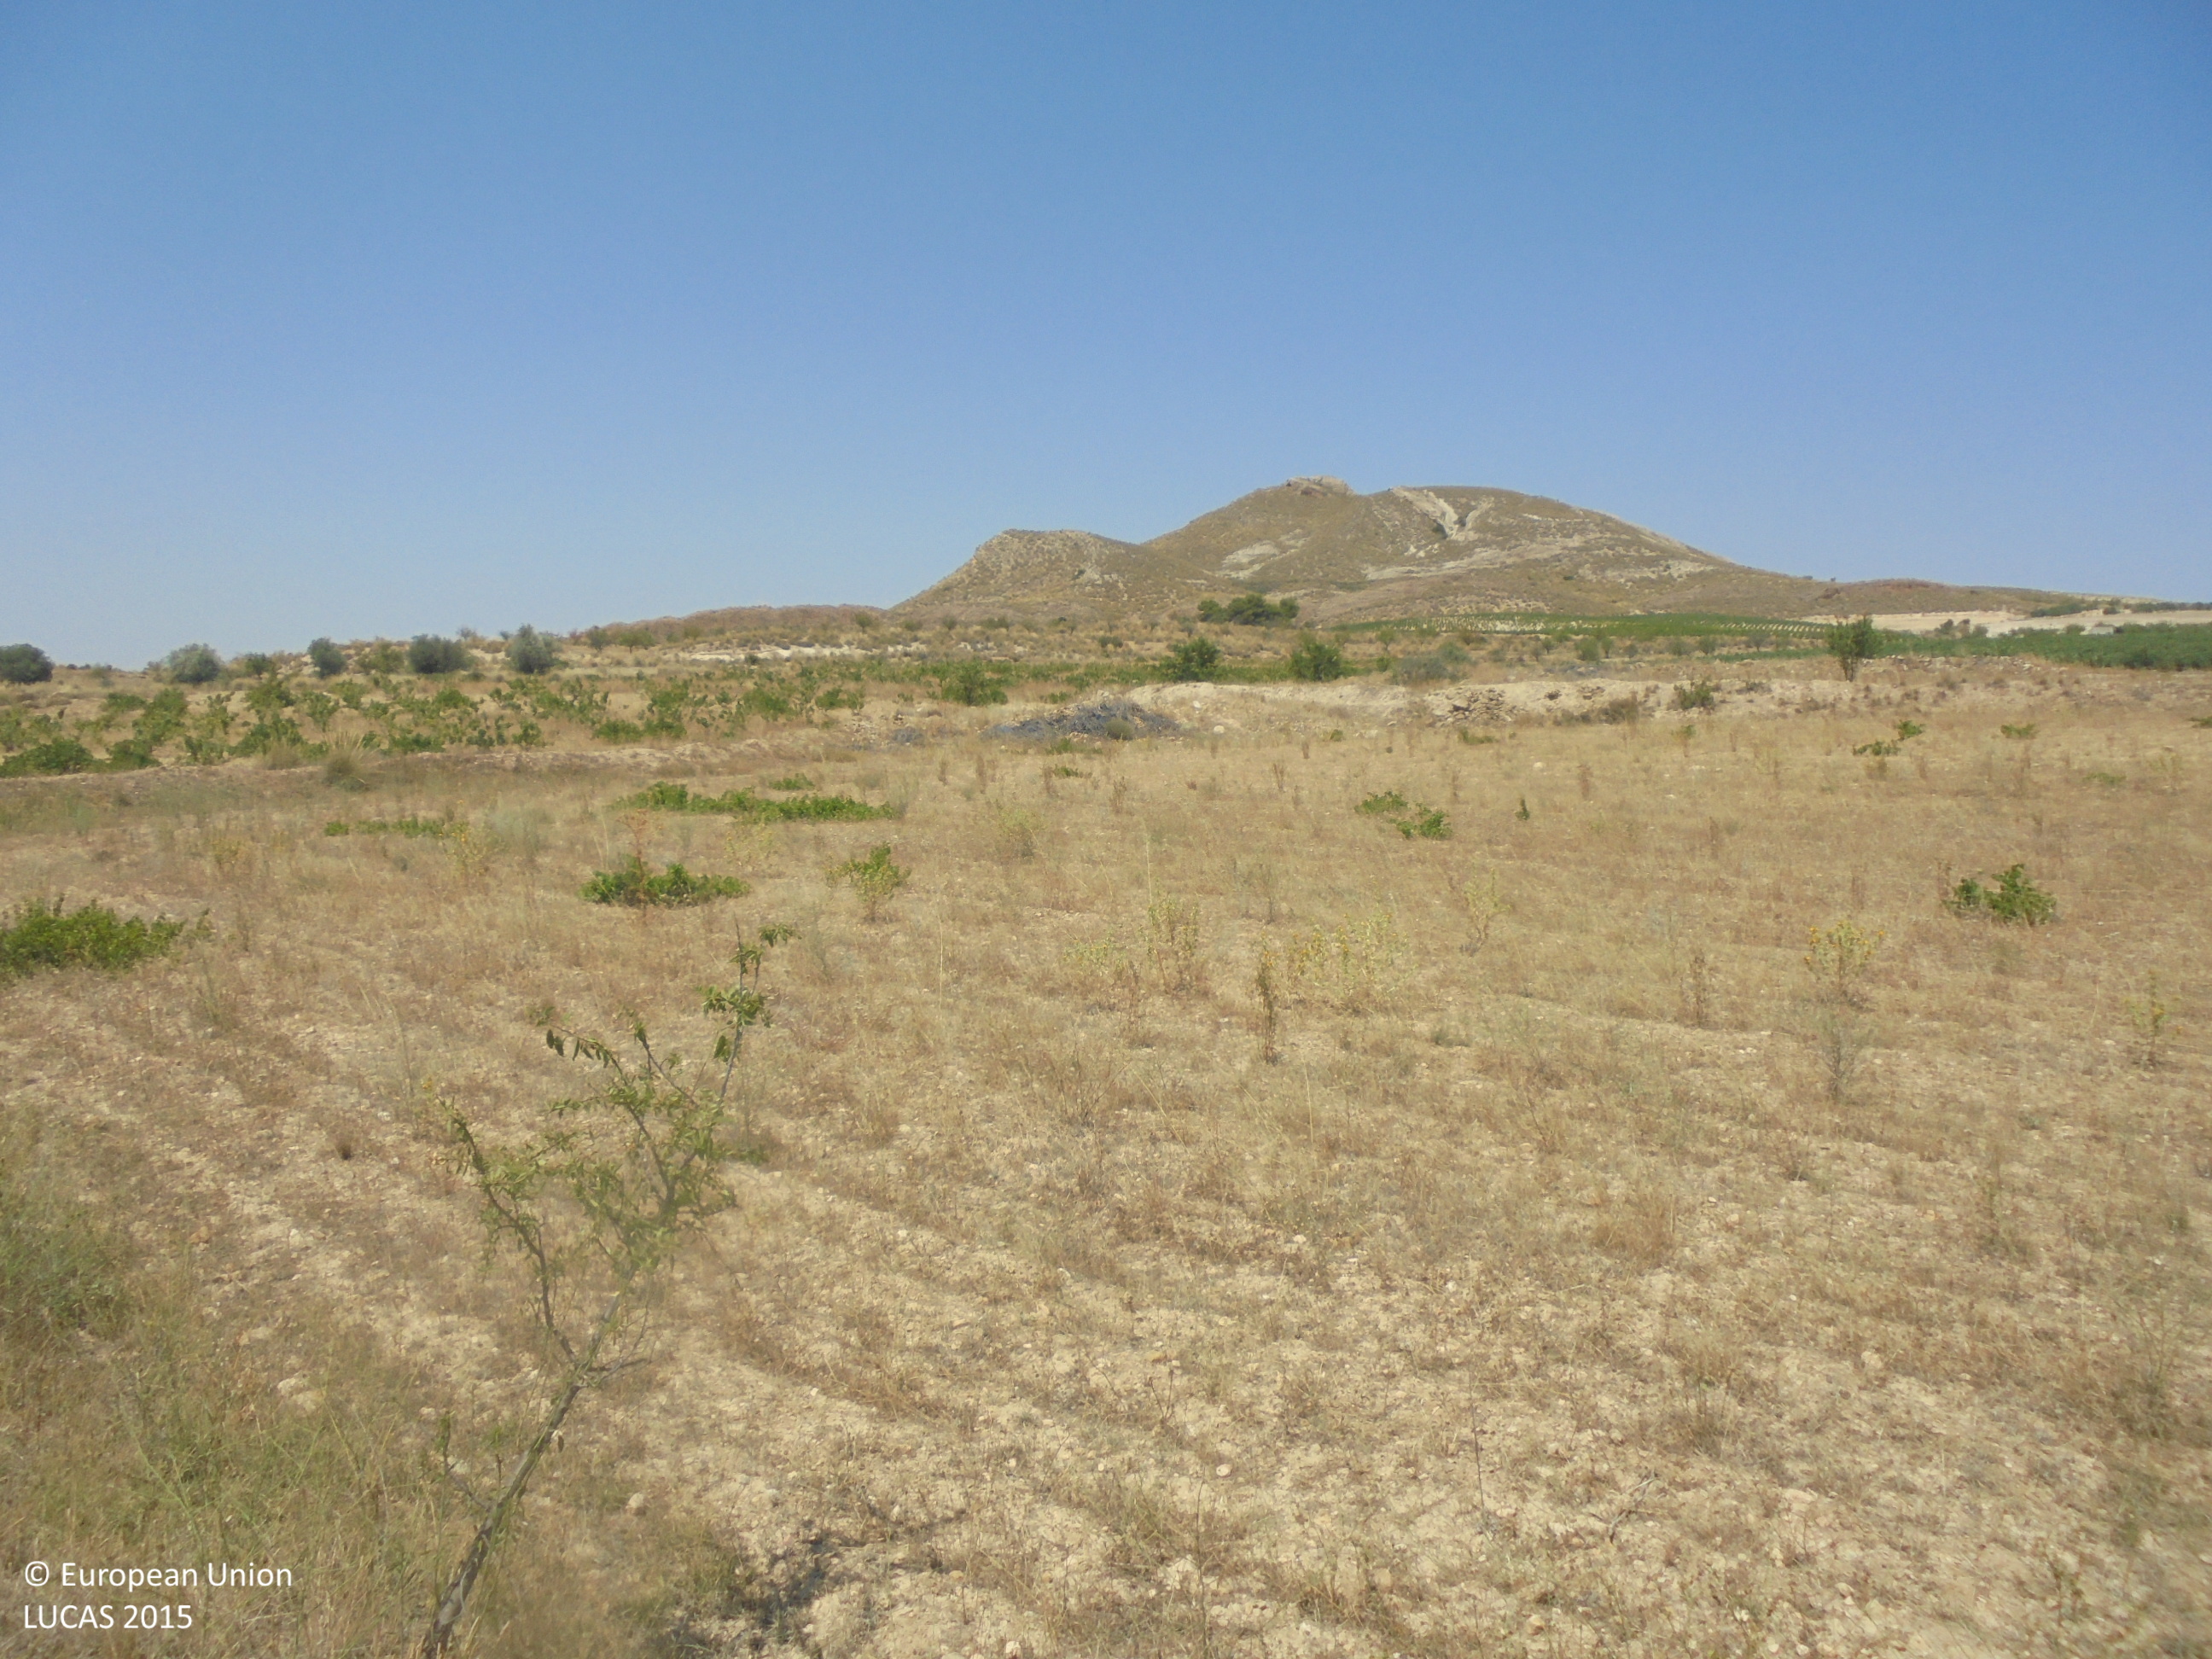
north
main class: Grassland
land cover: Grassland without tree/shrub cover
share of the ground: 25 - 50 %
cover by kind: unconsolidated bare surface 60 %, herbaceous plants 40 %
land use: Agriculture (excluding fallow land and kitchen gardens)
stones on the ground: 25 - 50 %
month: July
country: ES
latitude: 38.6628
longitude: -1.4516
